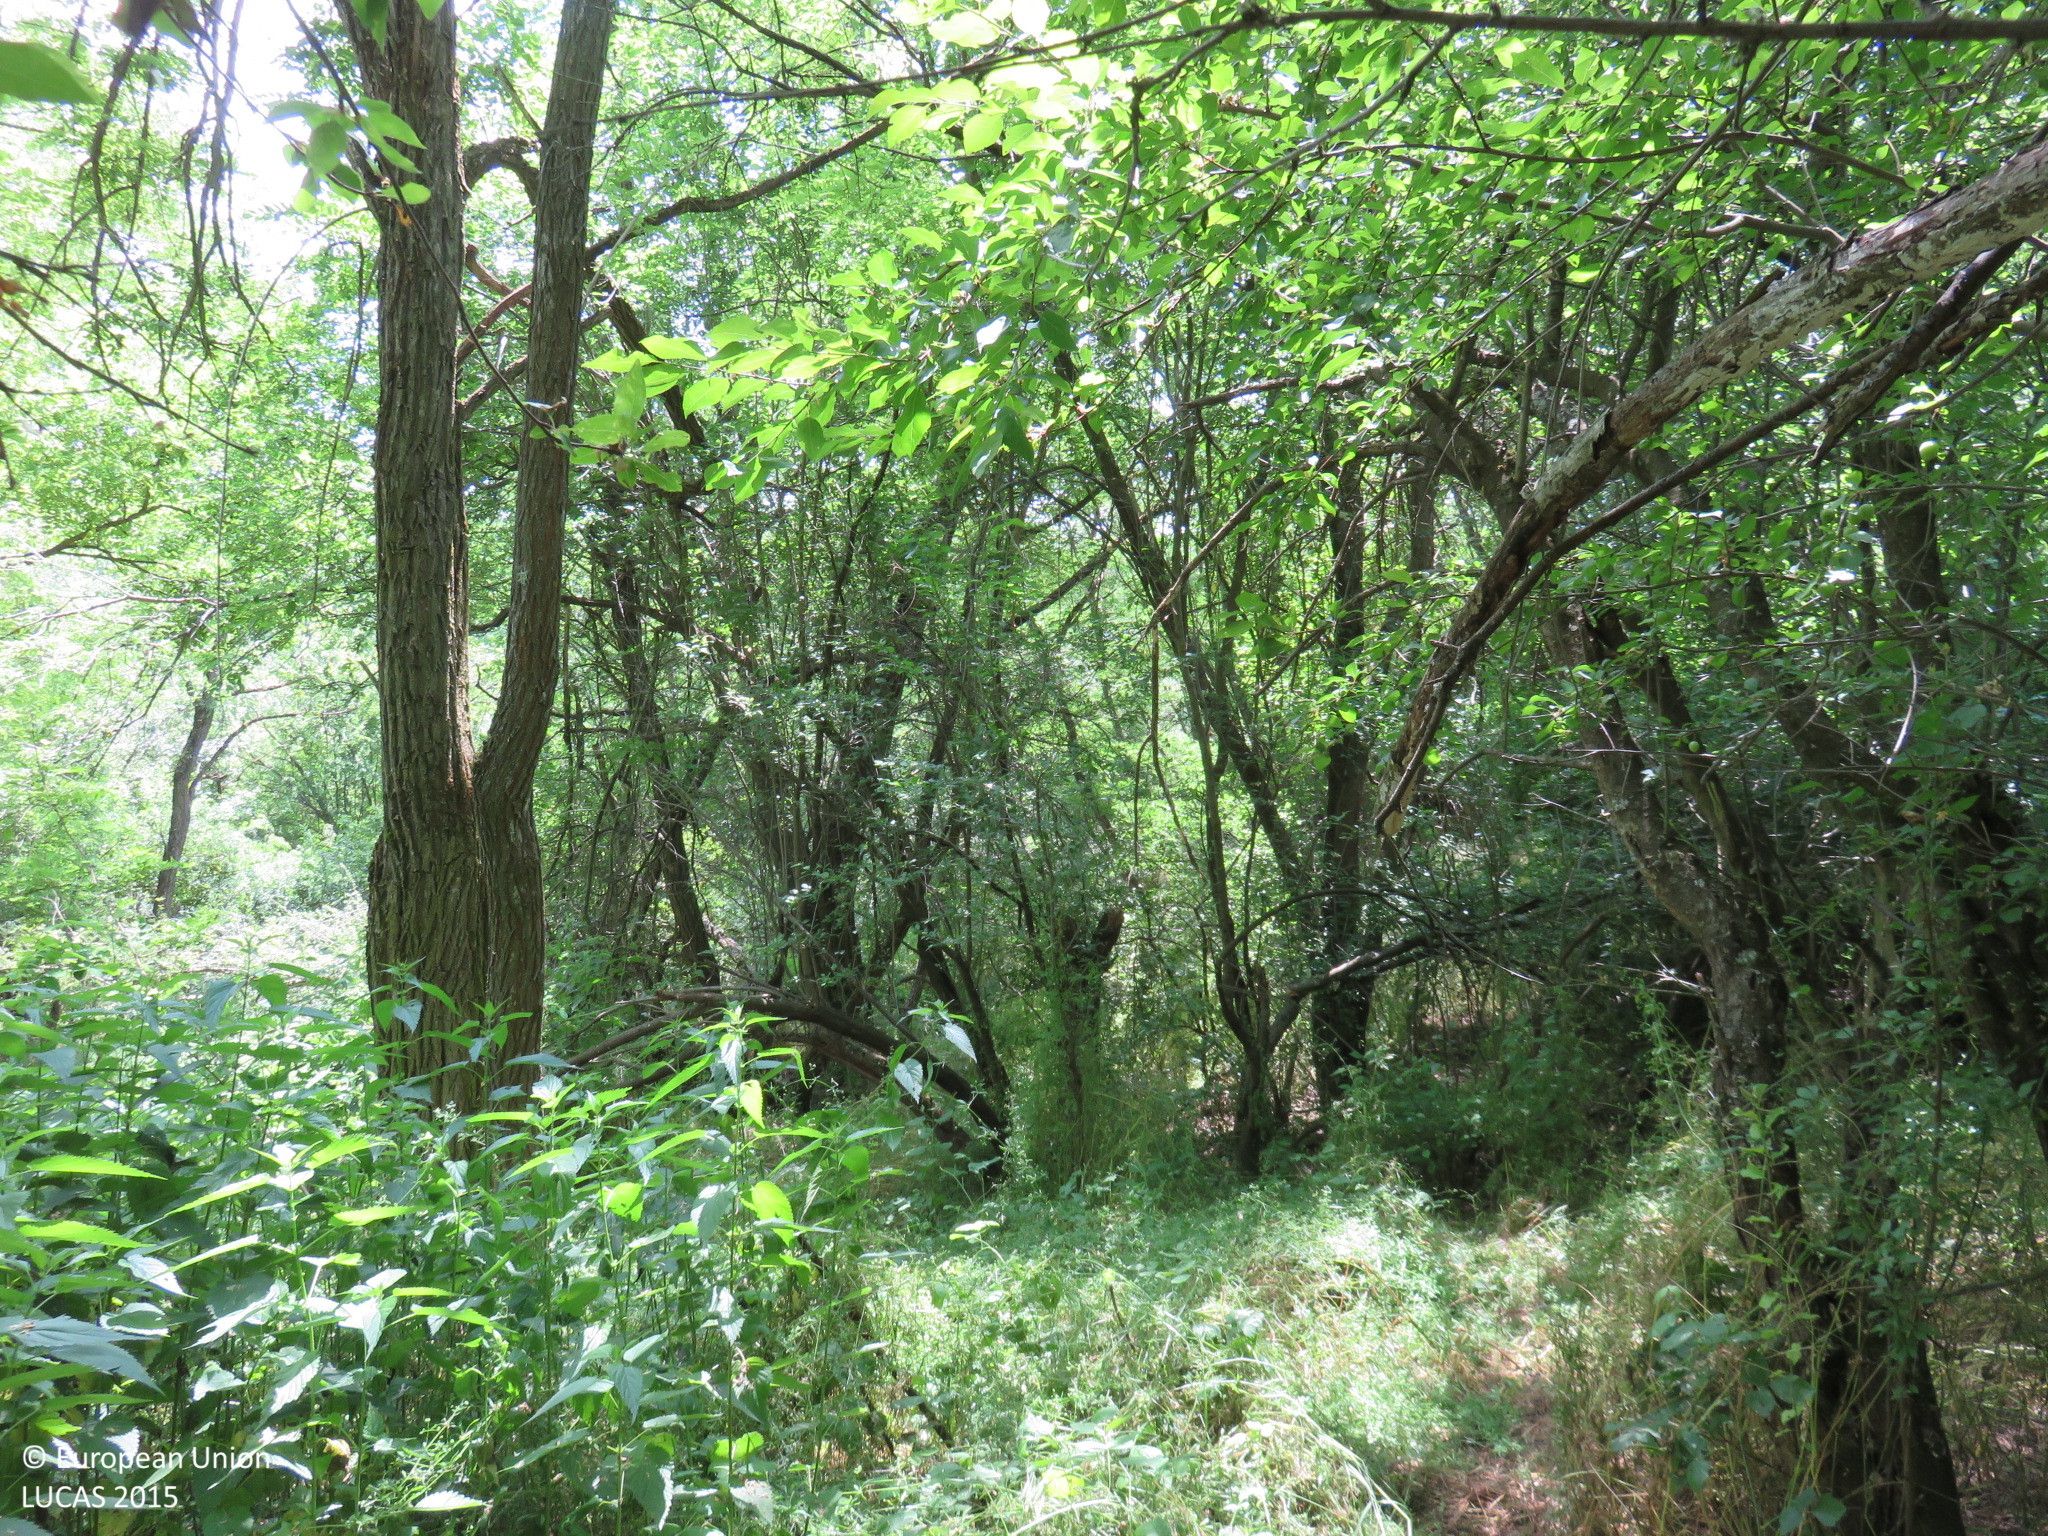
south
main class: Woodland
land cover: Broadleaved woodland
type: mesophytic deciduous forest
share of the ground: > 75 %
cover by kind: broadleaved forest trees 80 %, shrubs 10 %, herbaceous plants 10 %
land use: Forestry
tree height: < 5 m
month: June
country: BG
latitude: 43.2761
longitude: 24.4631
